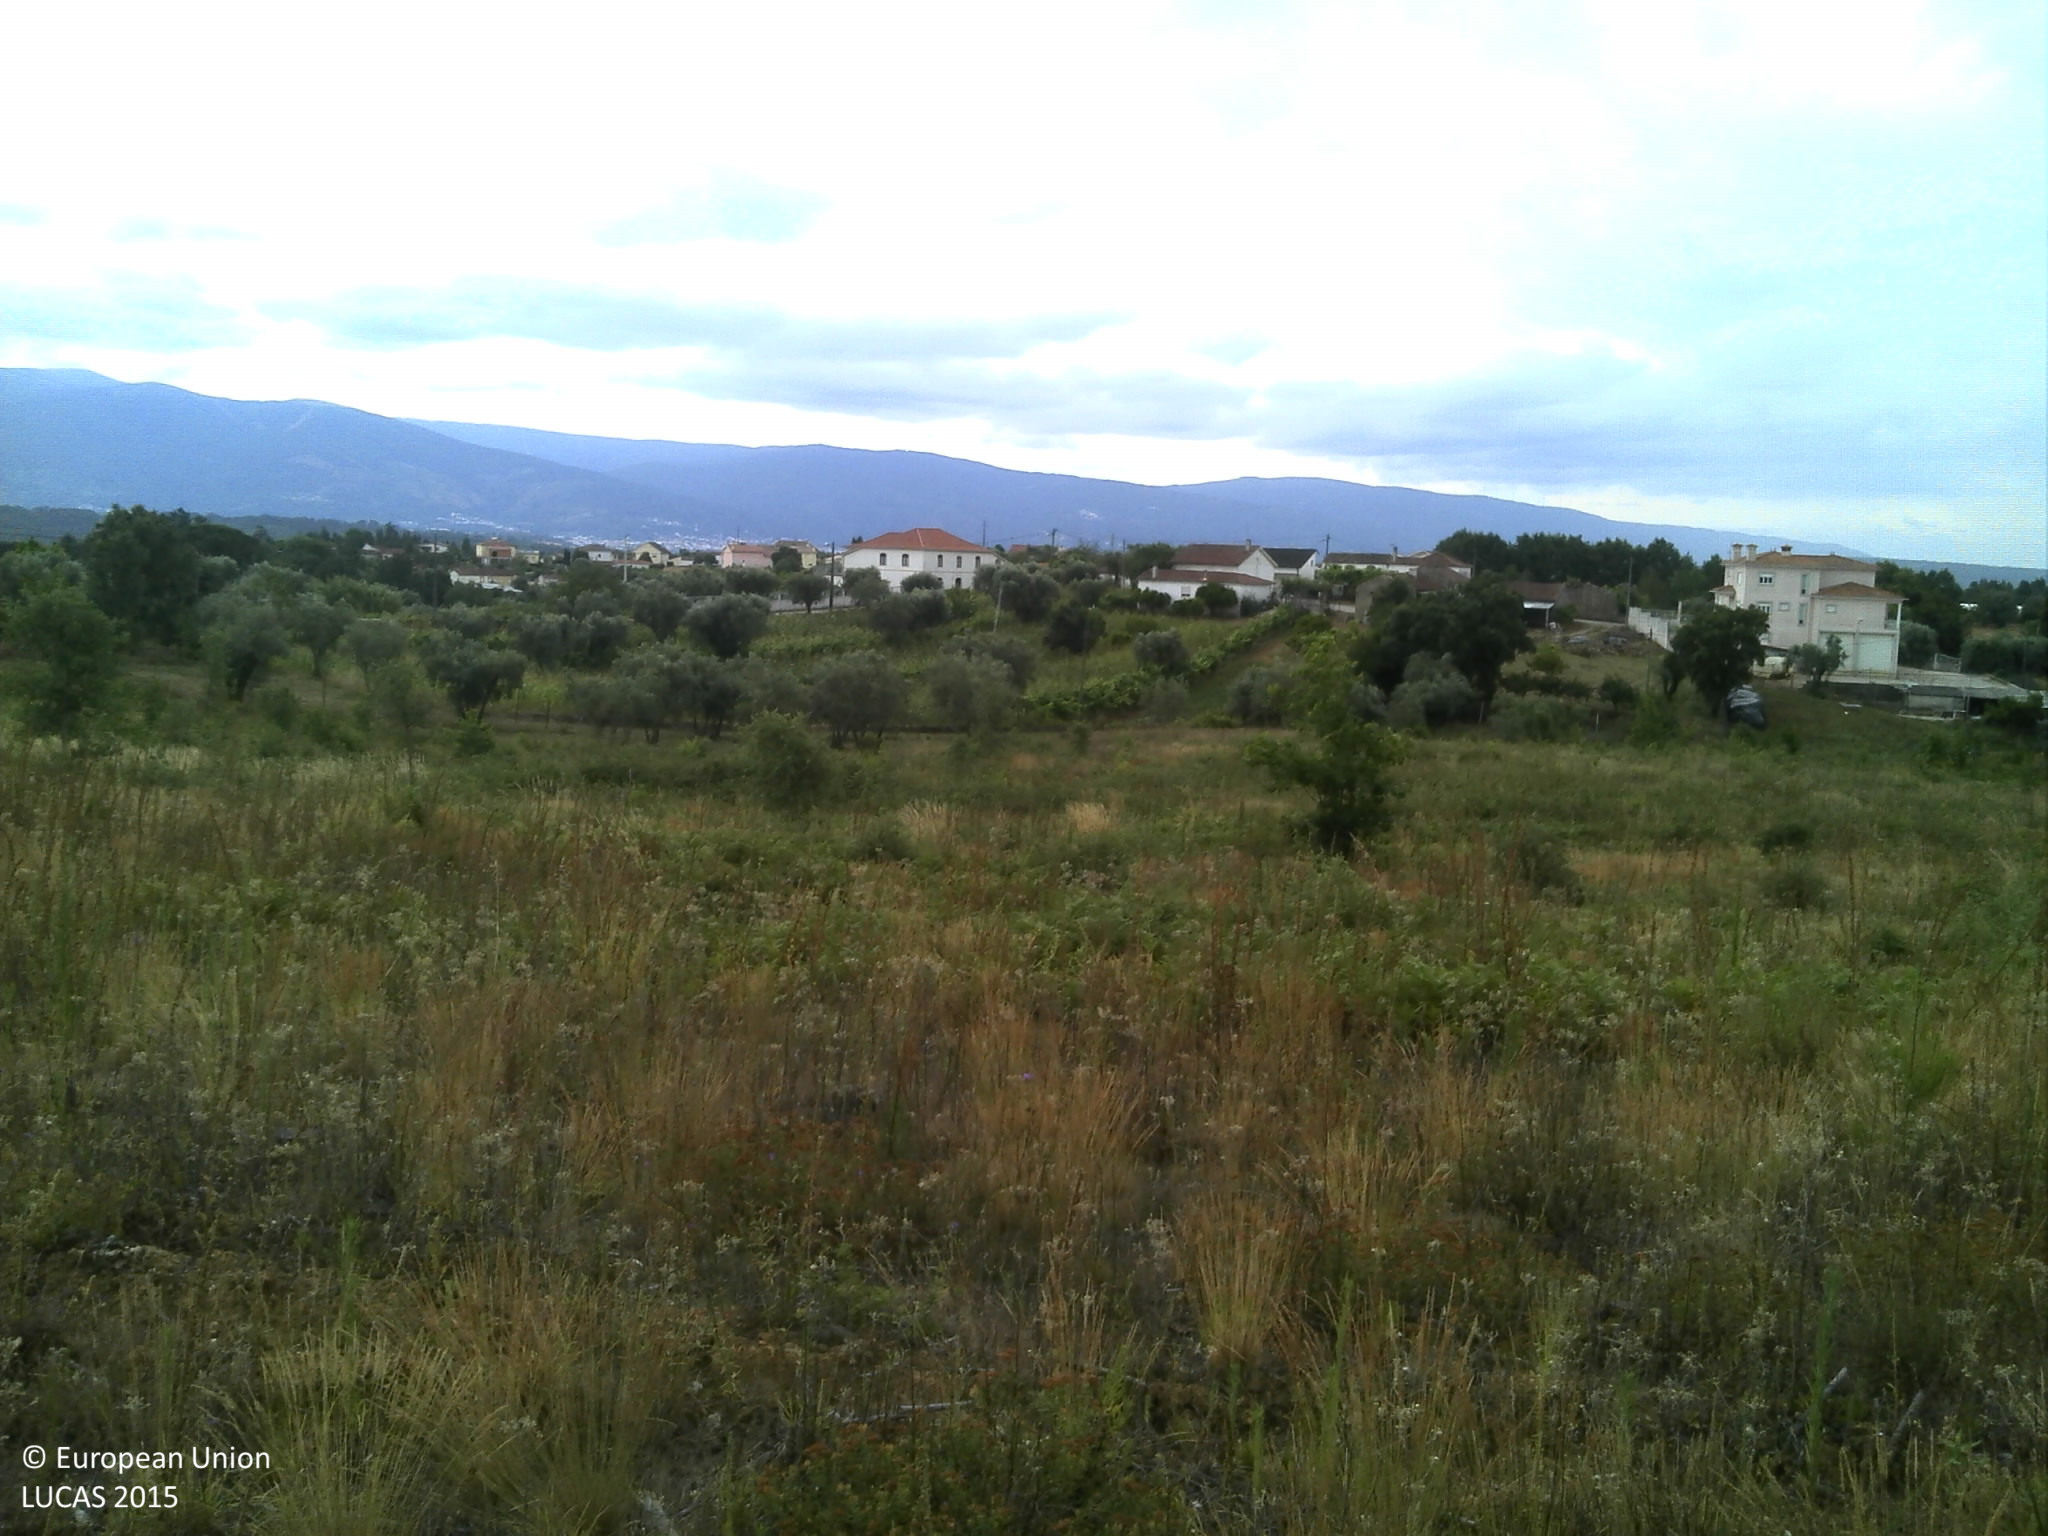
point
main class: Grassland
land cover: Spontaneously vegetated surfaces
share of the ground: > 75 %
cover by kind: herbaceous plants 80 %, unconsolidated bare surface 20 %
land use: Fallow land
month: July
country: PT
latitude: 40.1983
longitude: -8.2757
